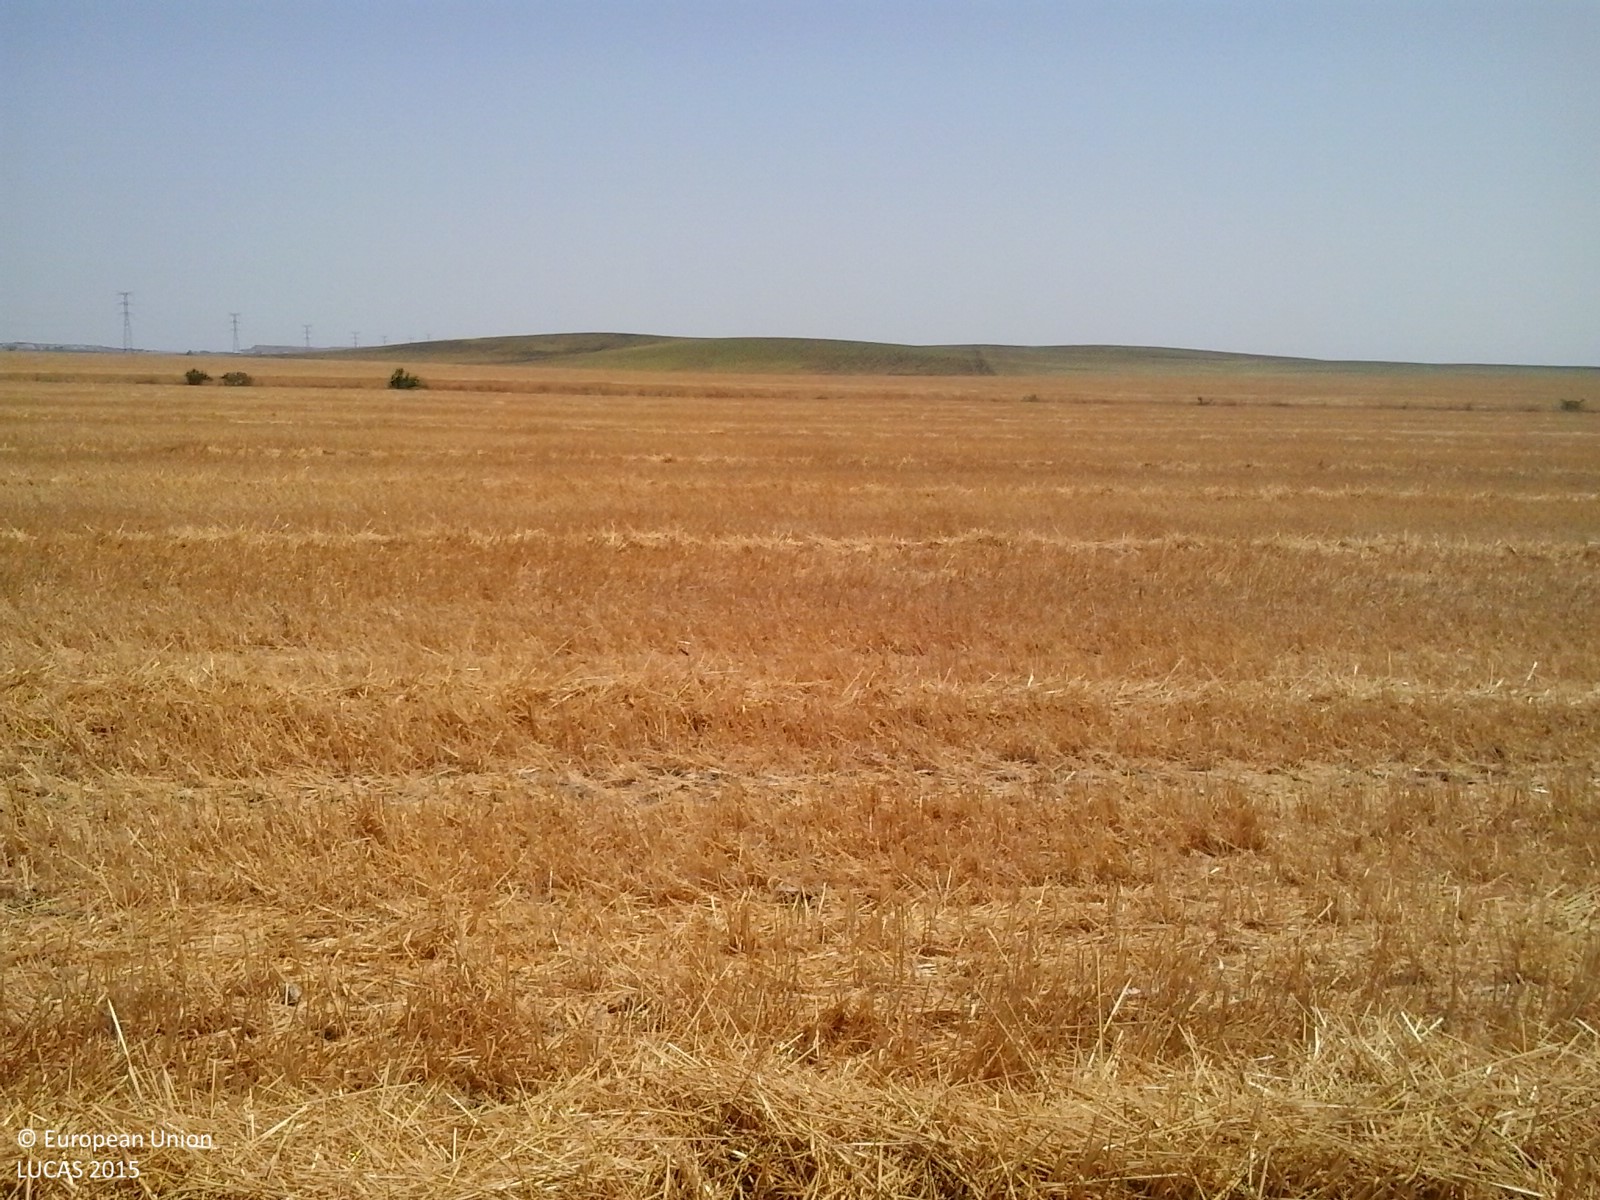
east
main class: Cropland
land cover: Sunflower
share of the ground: > 75 %
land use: Agriculture (excluding fallow land and kitchen gardens)
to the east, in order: Sunflower; Grass margins; Rivers and streams; Grass margins; Other bare soil; Grass margins; Rivers and streams; Grass margins
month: July
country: ES
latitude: 37.4705
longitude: -6.3244
